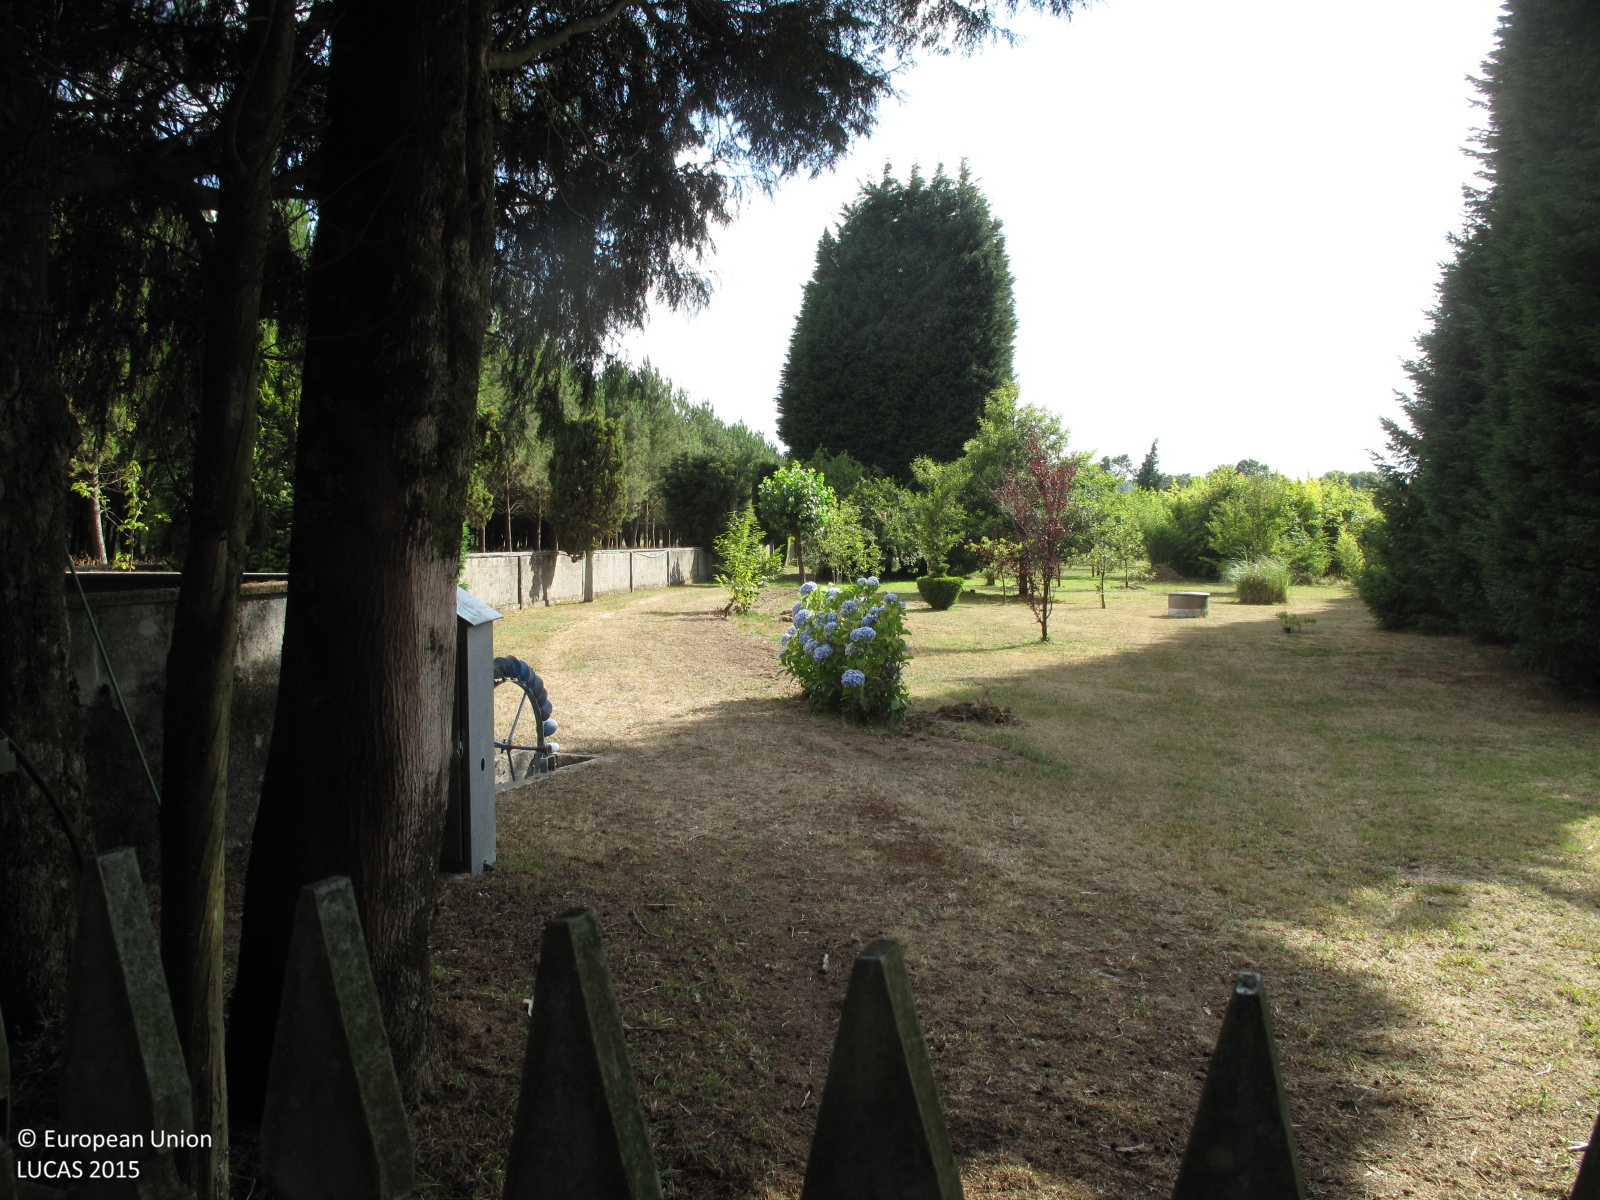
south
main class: Woodland
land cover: Other coniferous woodland
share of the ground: > 75 %
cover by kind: coniferous forest trees 80 %, shrubs 20 %
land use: Community services
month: July
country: ES
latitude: 43.0810
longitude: -7.9613
